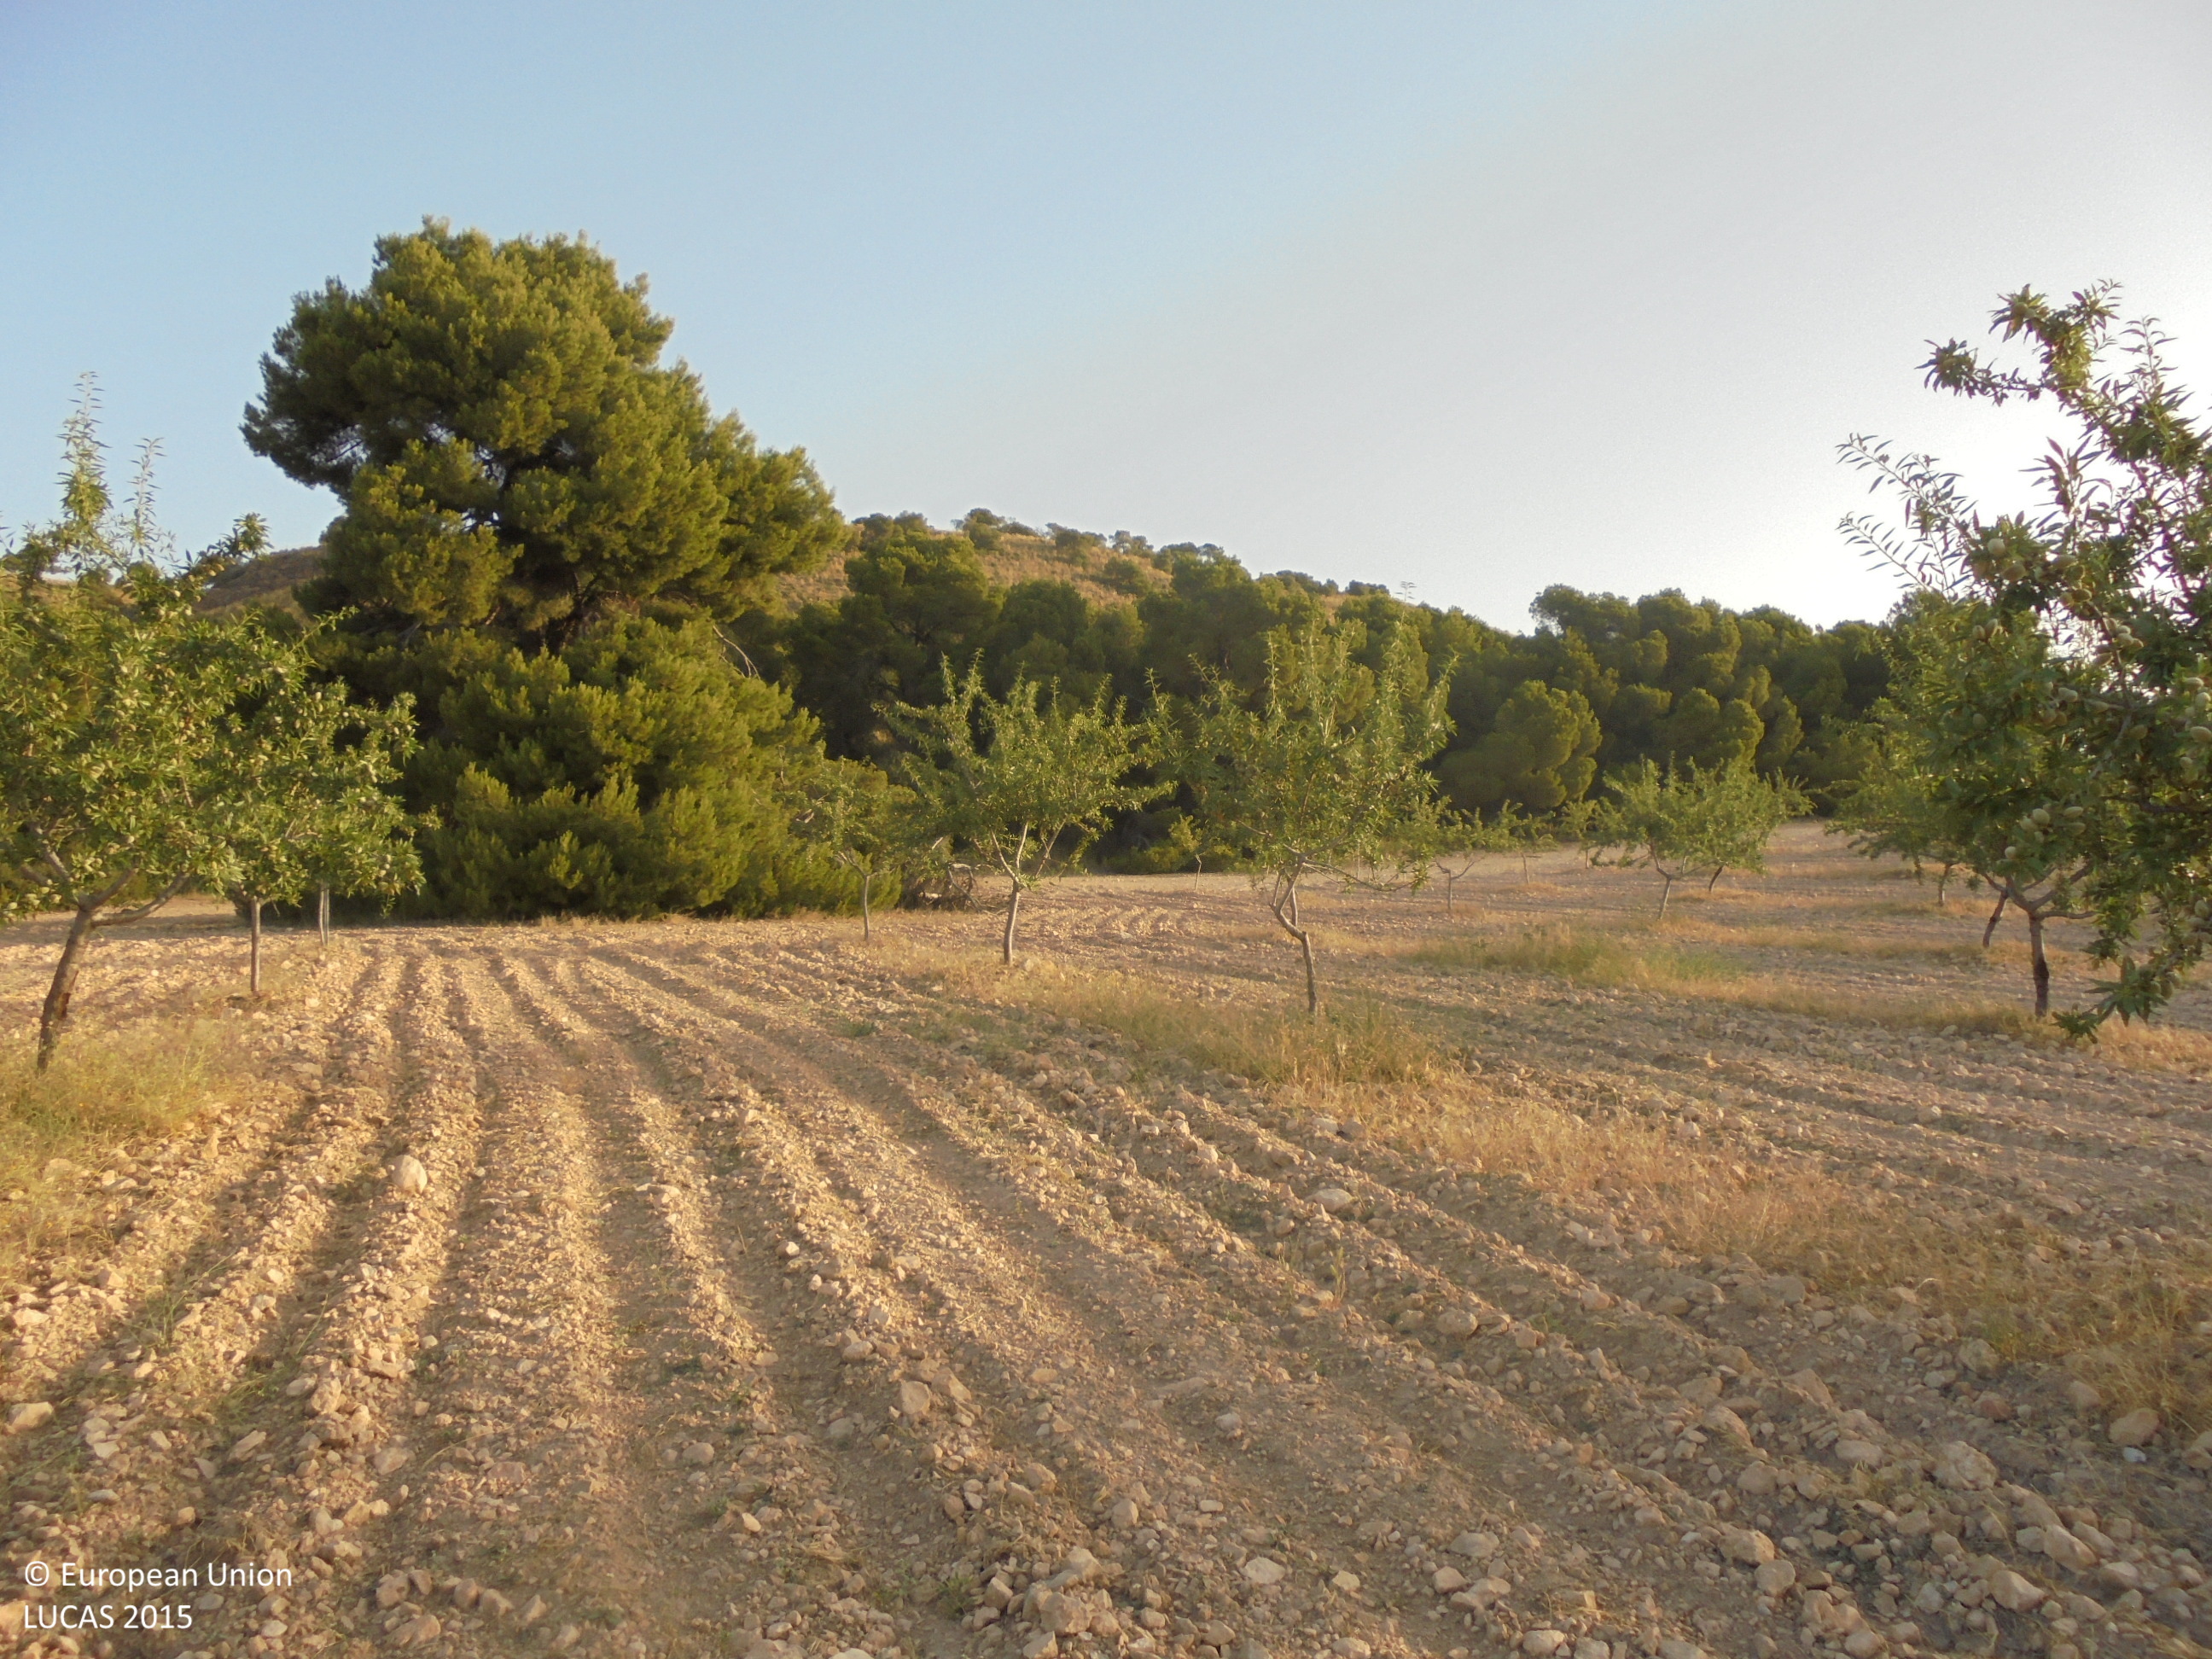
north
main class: Cropland
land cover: Nuts trees
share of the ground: 10 - 25 %
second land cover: Spontaneously vegetated surfaces
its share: 25 - 50 %
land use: Agriculture (excluding fallow land and kitchen gardens)
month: July
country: ES
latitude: 38.7221
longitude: -1.7165
